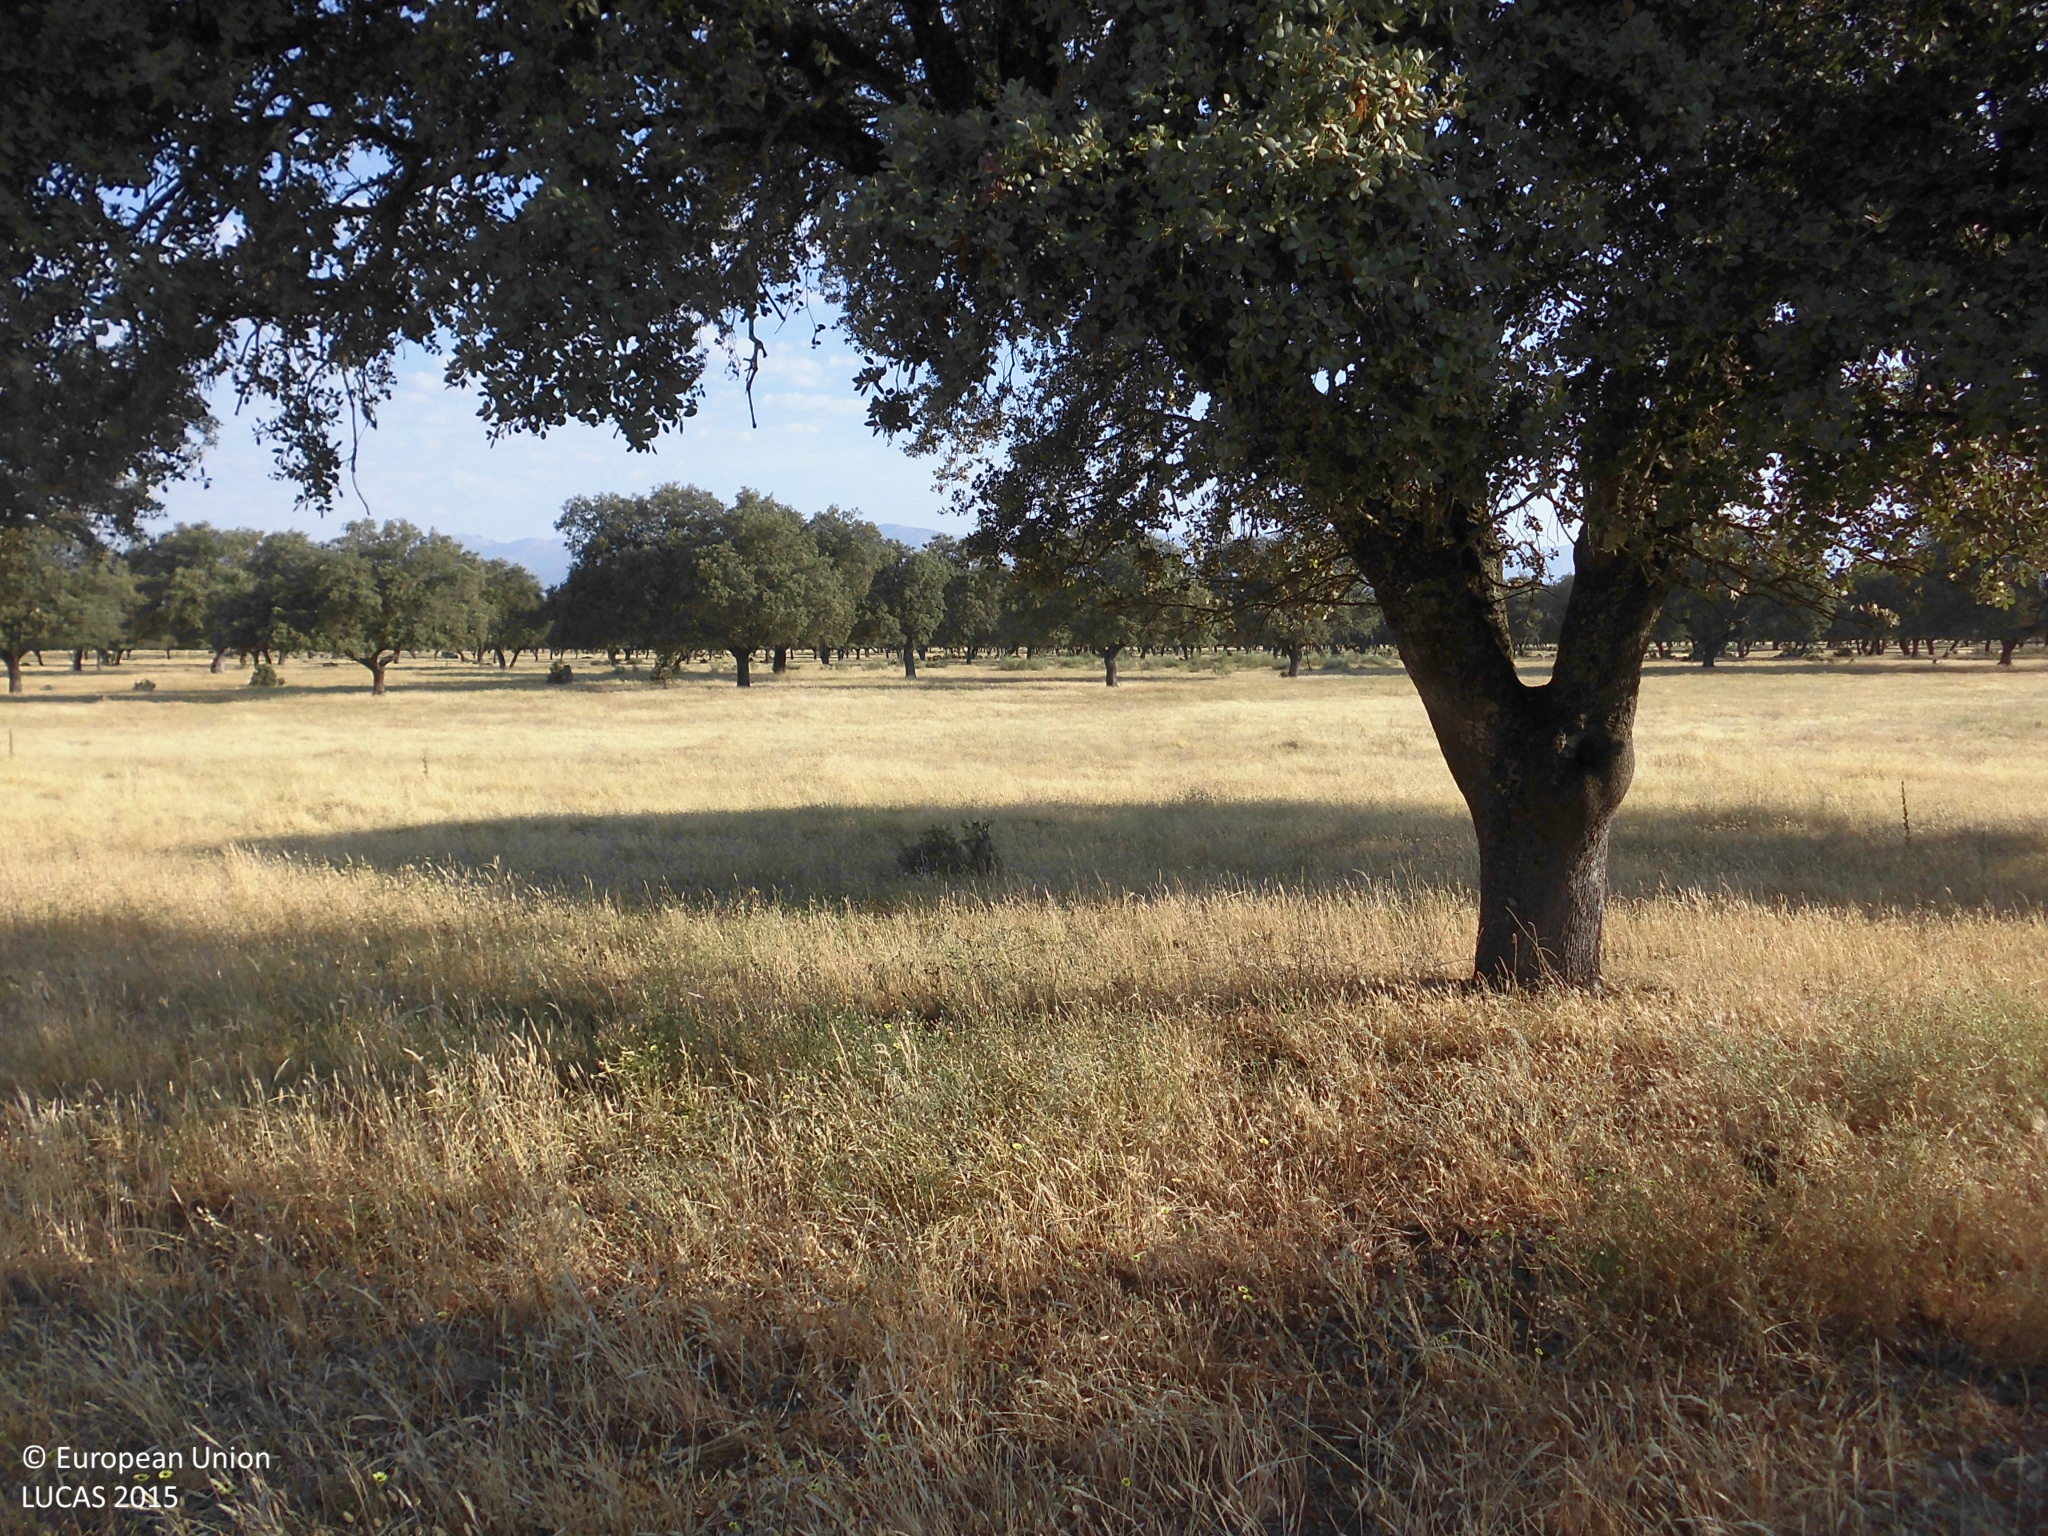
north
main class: Woodland
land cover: Broadleaved woodland
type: broadleaved evergreen forest
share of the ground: 10 - 25 %
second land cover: Grassland without tree/shrub cover
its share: > 75 %
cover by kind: herbaceous plants 80 %, broadleaved forest trees 20 %
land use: Forestry
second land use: Agriculture (excluding fallow land and kitchen gardens)
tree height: > 5 m
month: June
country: ES
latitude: 39.9791
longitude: -5.4093
